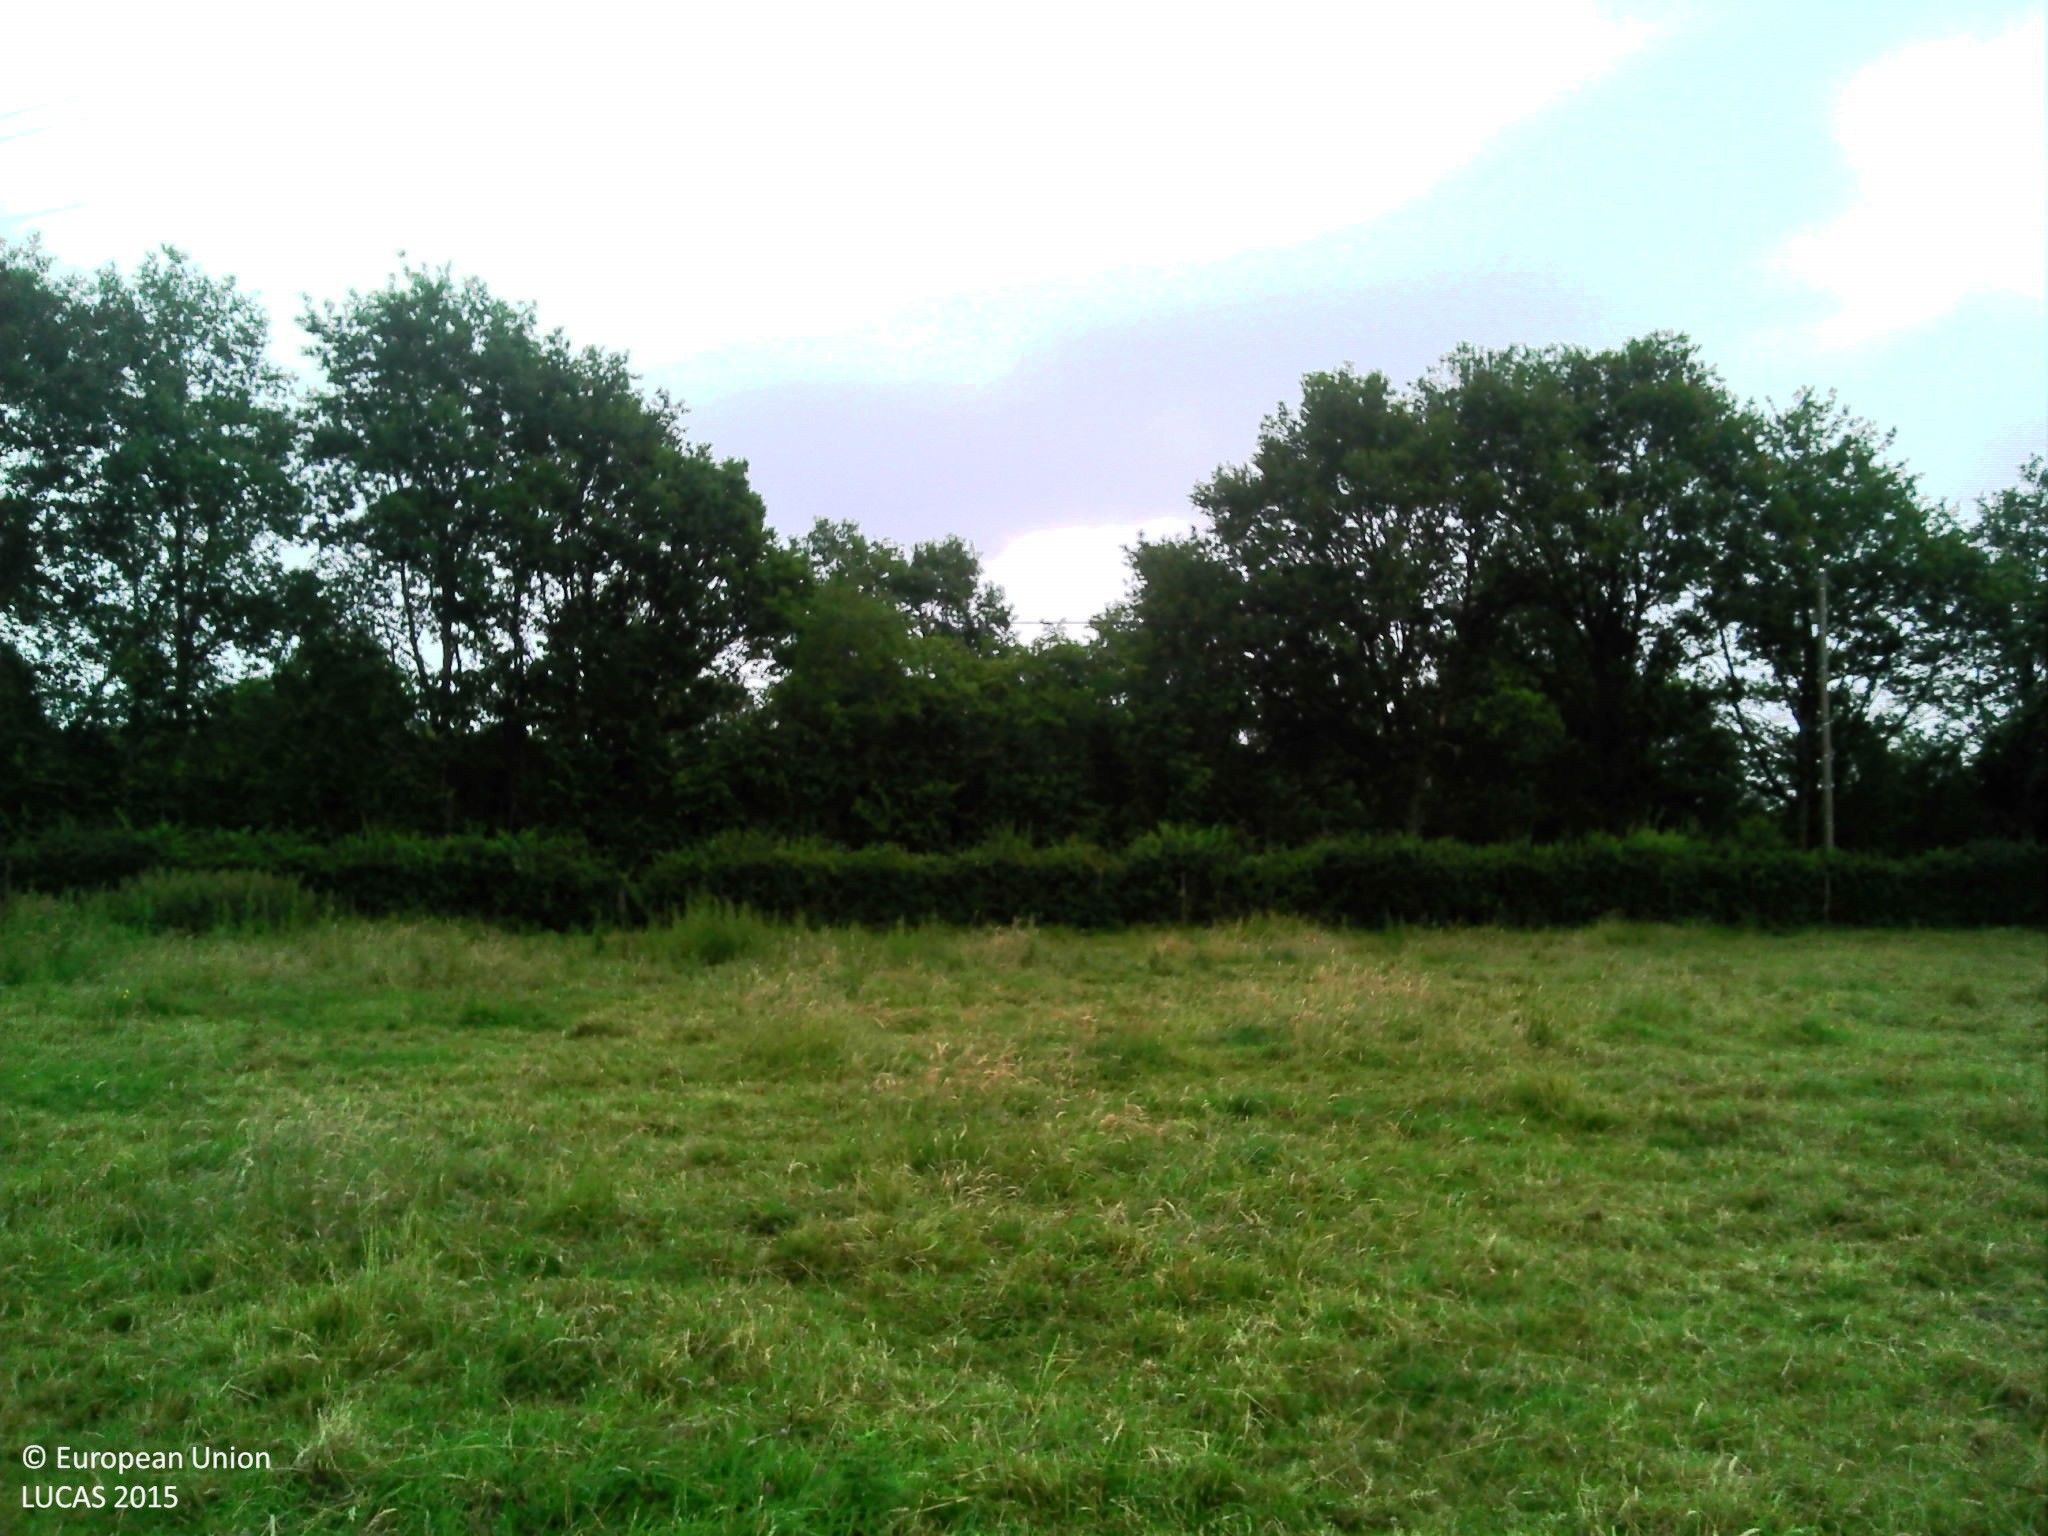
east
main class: Grassland
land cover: Grassland without tree/shrub cover
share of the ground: > 75 %
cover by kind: herbaceous plants 100 %
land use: Agriculture (excluding fallow land and kitchen gardens)
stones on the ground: < 10 %
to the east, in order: Grassland without tree/shrub cover; Fences; Managed hedges; Grass margins; Tracks; Grass margins; Broadleaved woodland; Fences; Grassland without tree/shrub cover; Fences; Broadleaved woodland; Fences; Grassland without tree/shrub cover; Fences; Broadleaved woodland; Grass margins; Maize; Managed hedges; Maize
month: June
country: FR
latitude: 48.1557
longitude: 0.2818
